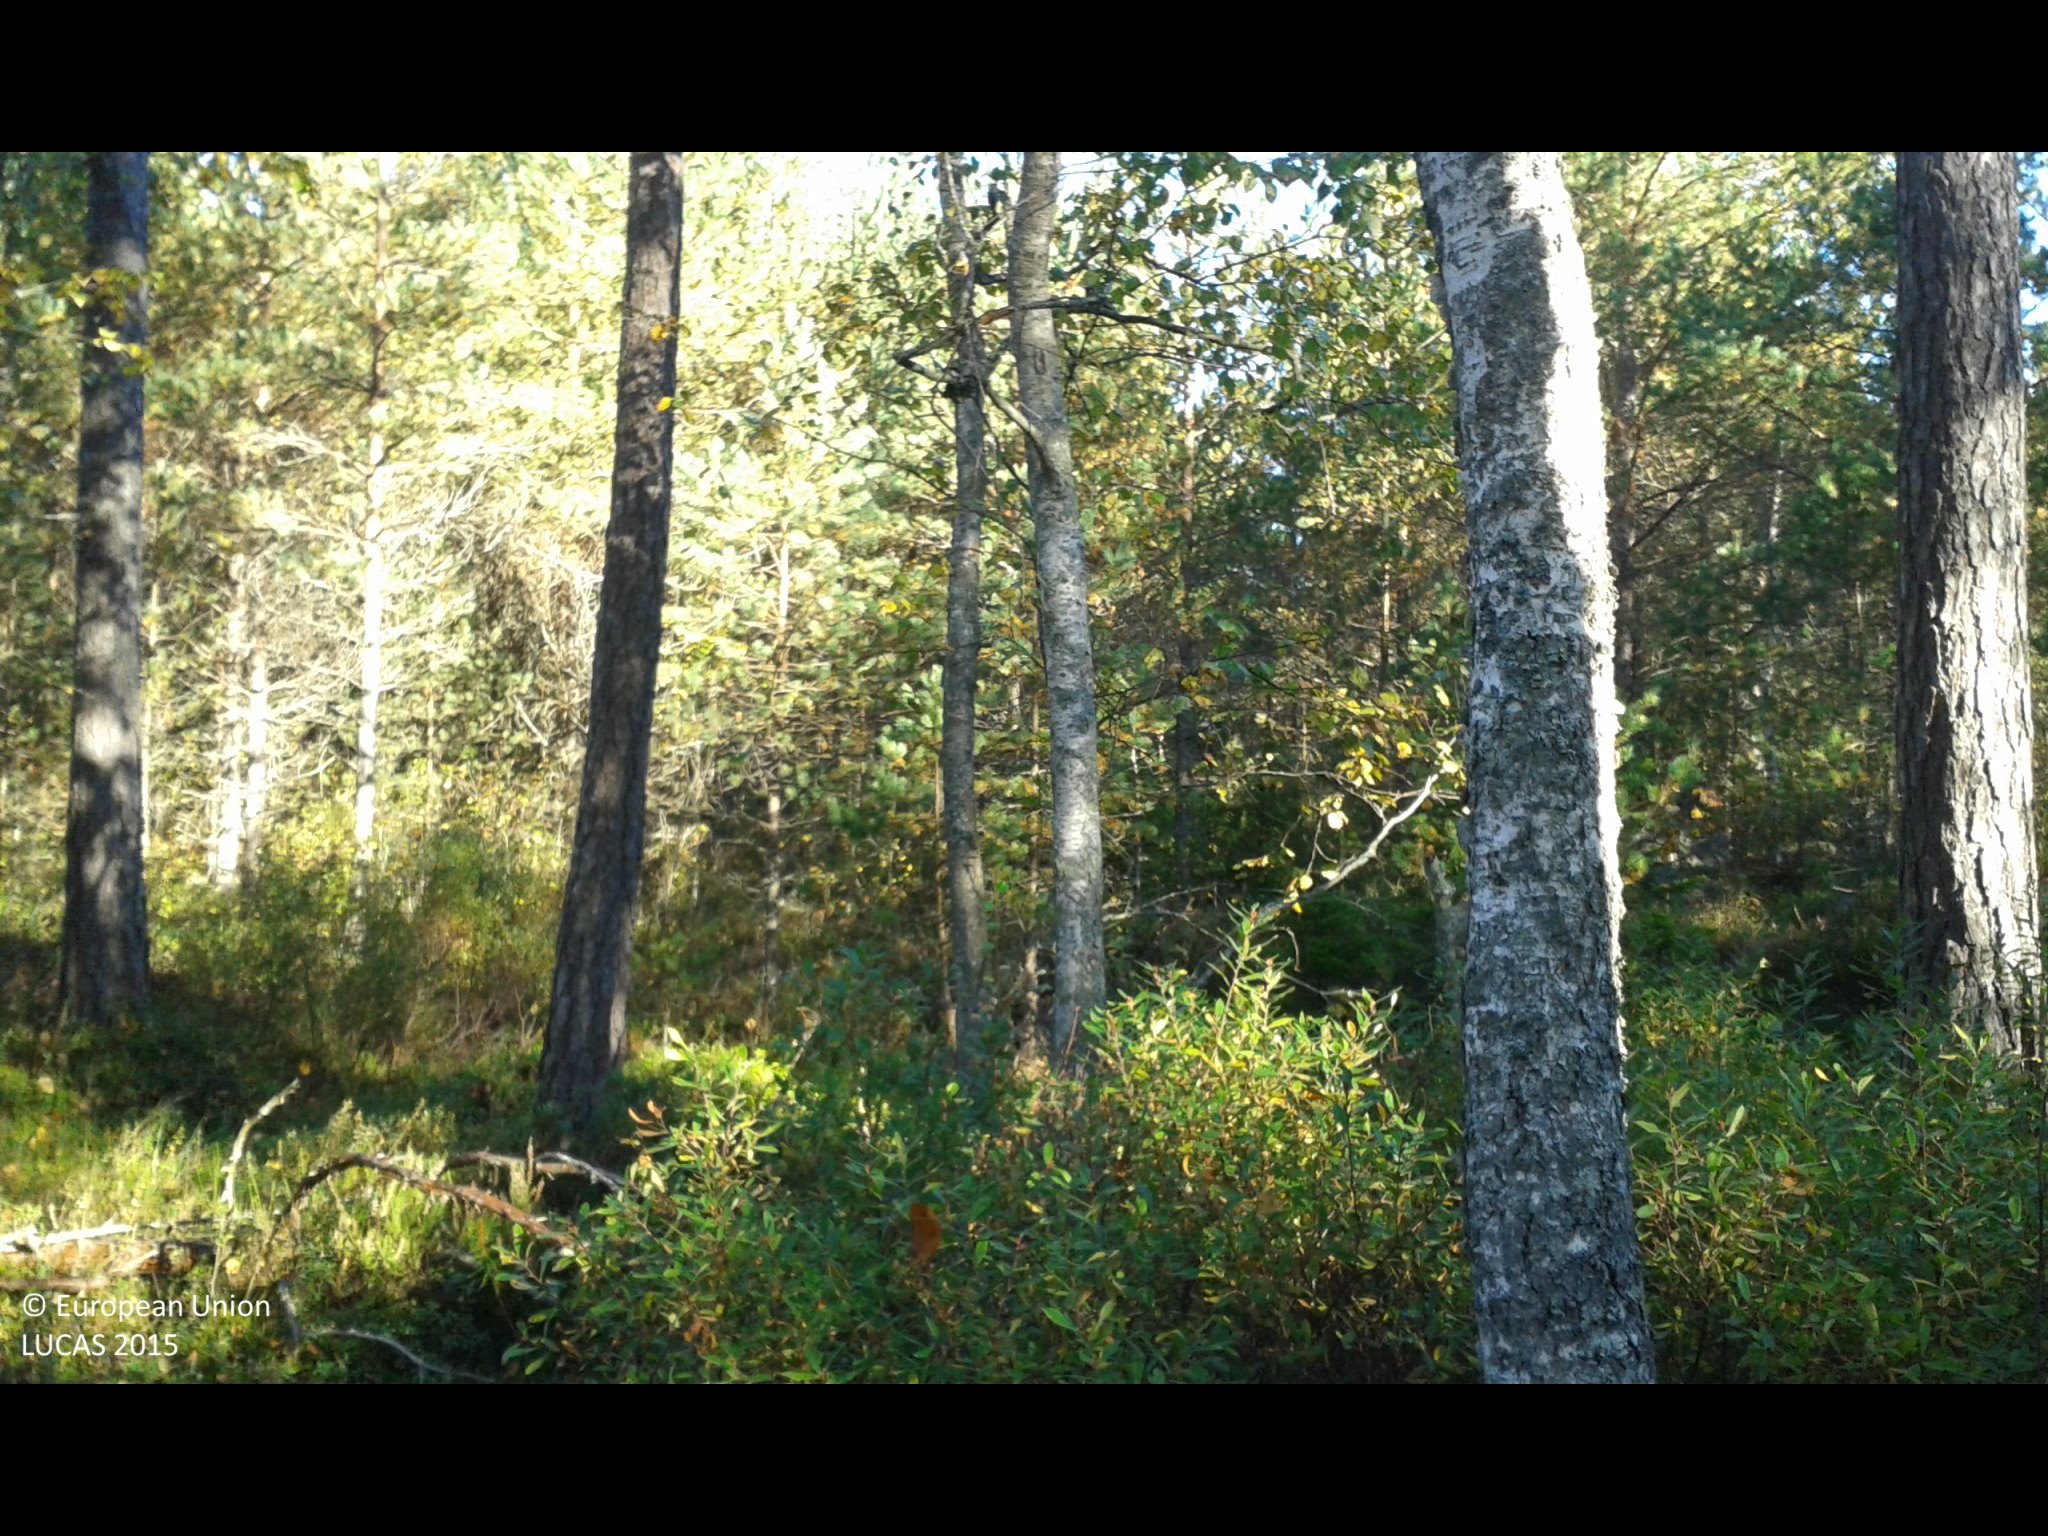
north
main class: Woodland
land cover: Pine dominated mixed woodland
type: hemiboreal forest and nemoral coniferous forest and mixed broadleaved-coniferous forest
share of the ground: 50 - 75 %
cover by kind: coniferous forest trees 35 %, broadleaved forest trees 35 %, herbaceous plants 30 %
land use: Forestry
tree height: > 5 m
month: September
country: SE
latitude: 59.0795
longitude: 17.4472
